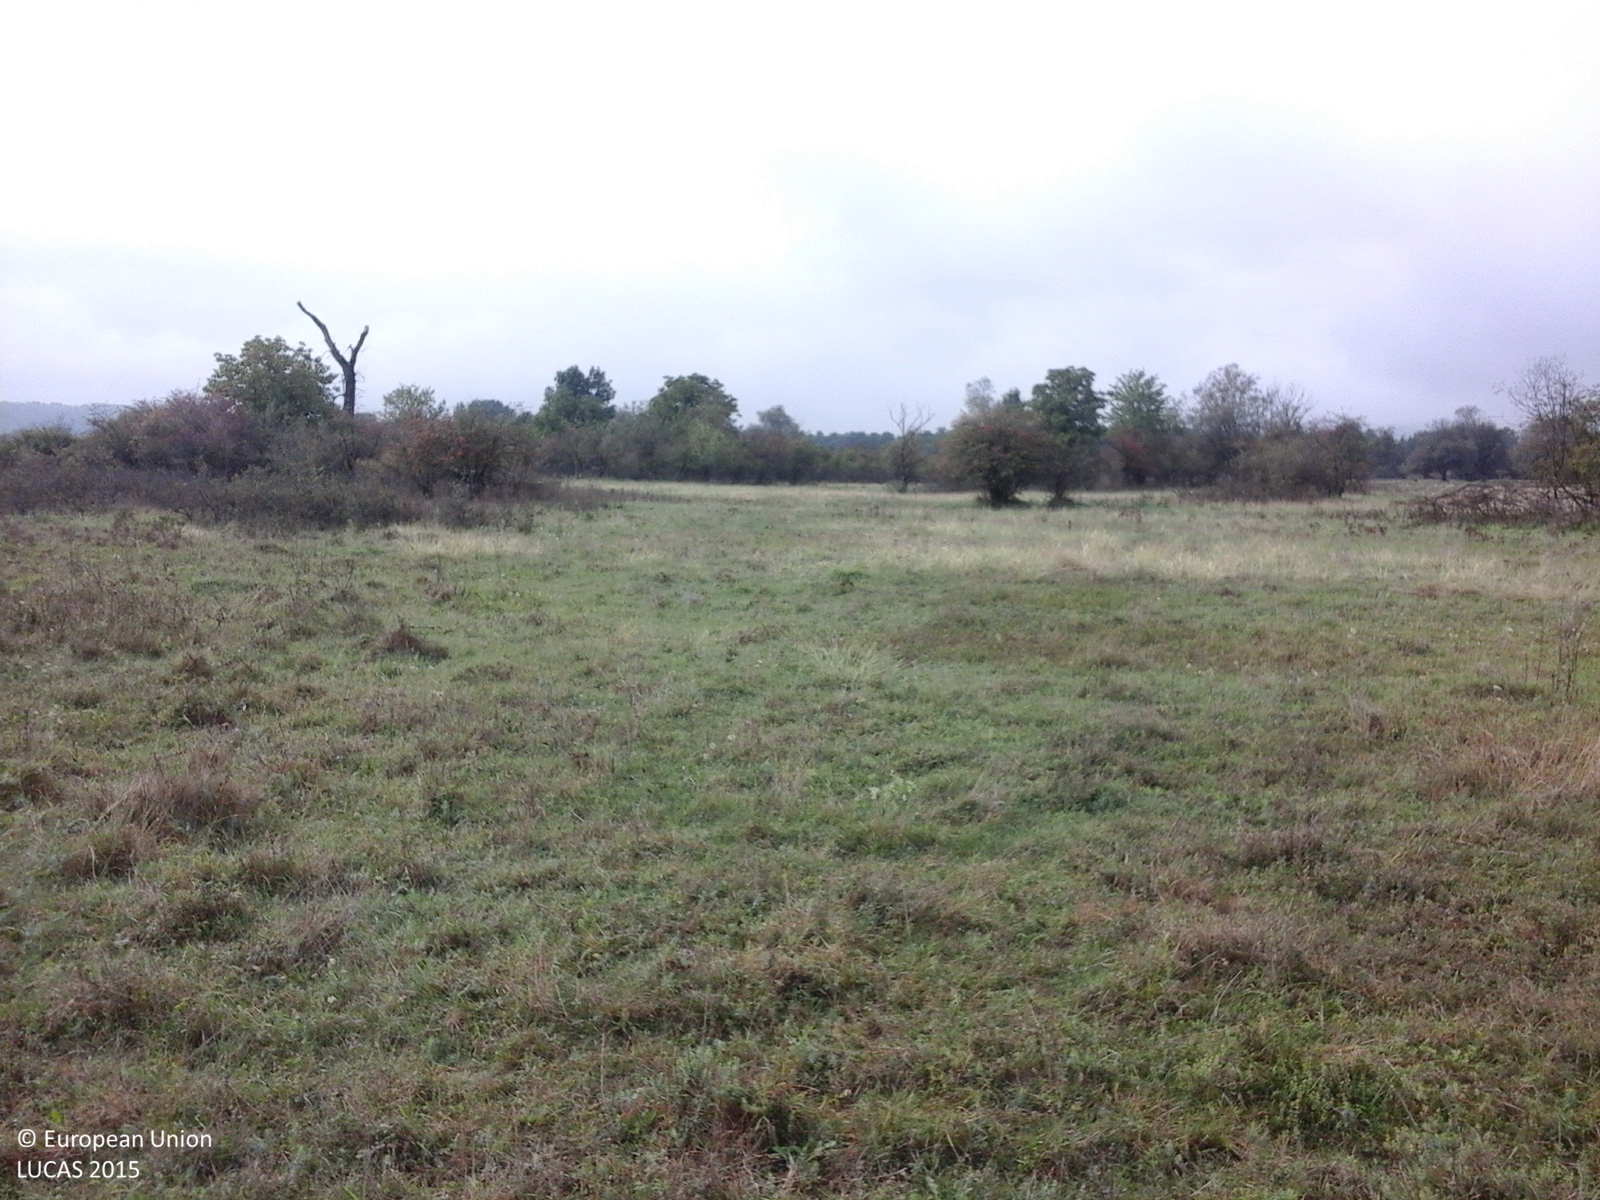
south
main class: Grassland
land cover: Grassland with sparse tree/shrub cover
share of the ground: > 75 %
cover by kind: herbaceous plants 85 %, shrubs 10 %, broadleaved forest trees 5 %
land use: Fallow land
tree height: < 5 m
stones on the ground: < 10 %
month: September
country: RO
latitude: 45.0792
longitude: 23.1494
